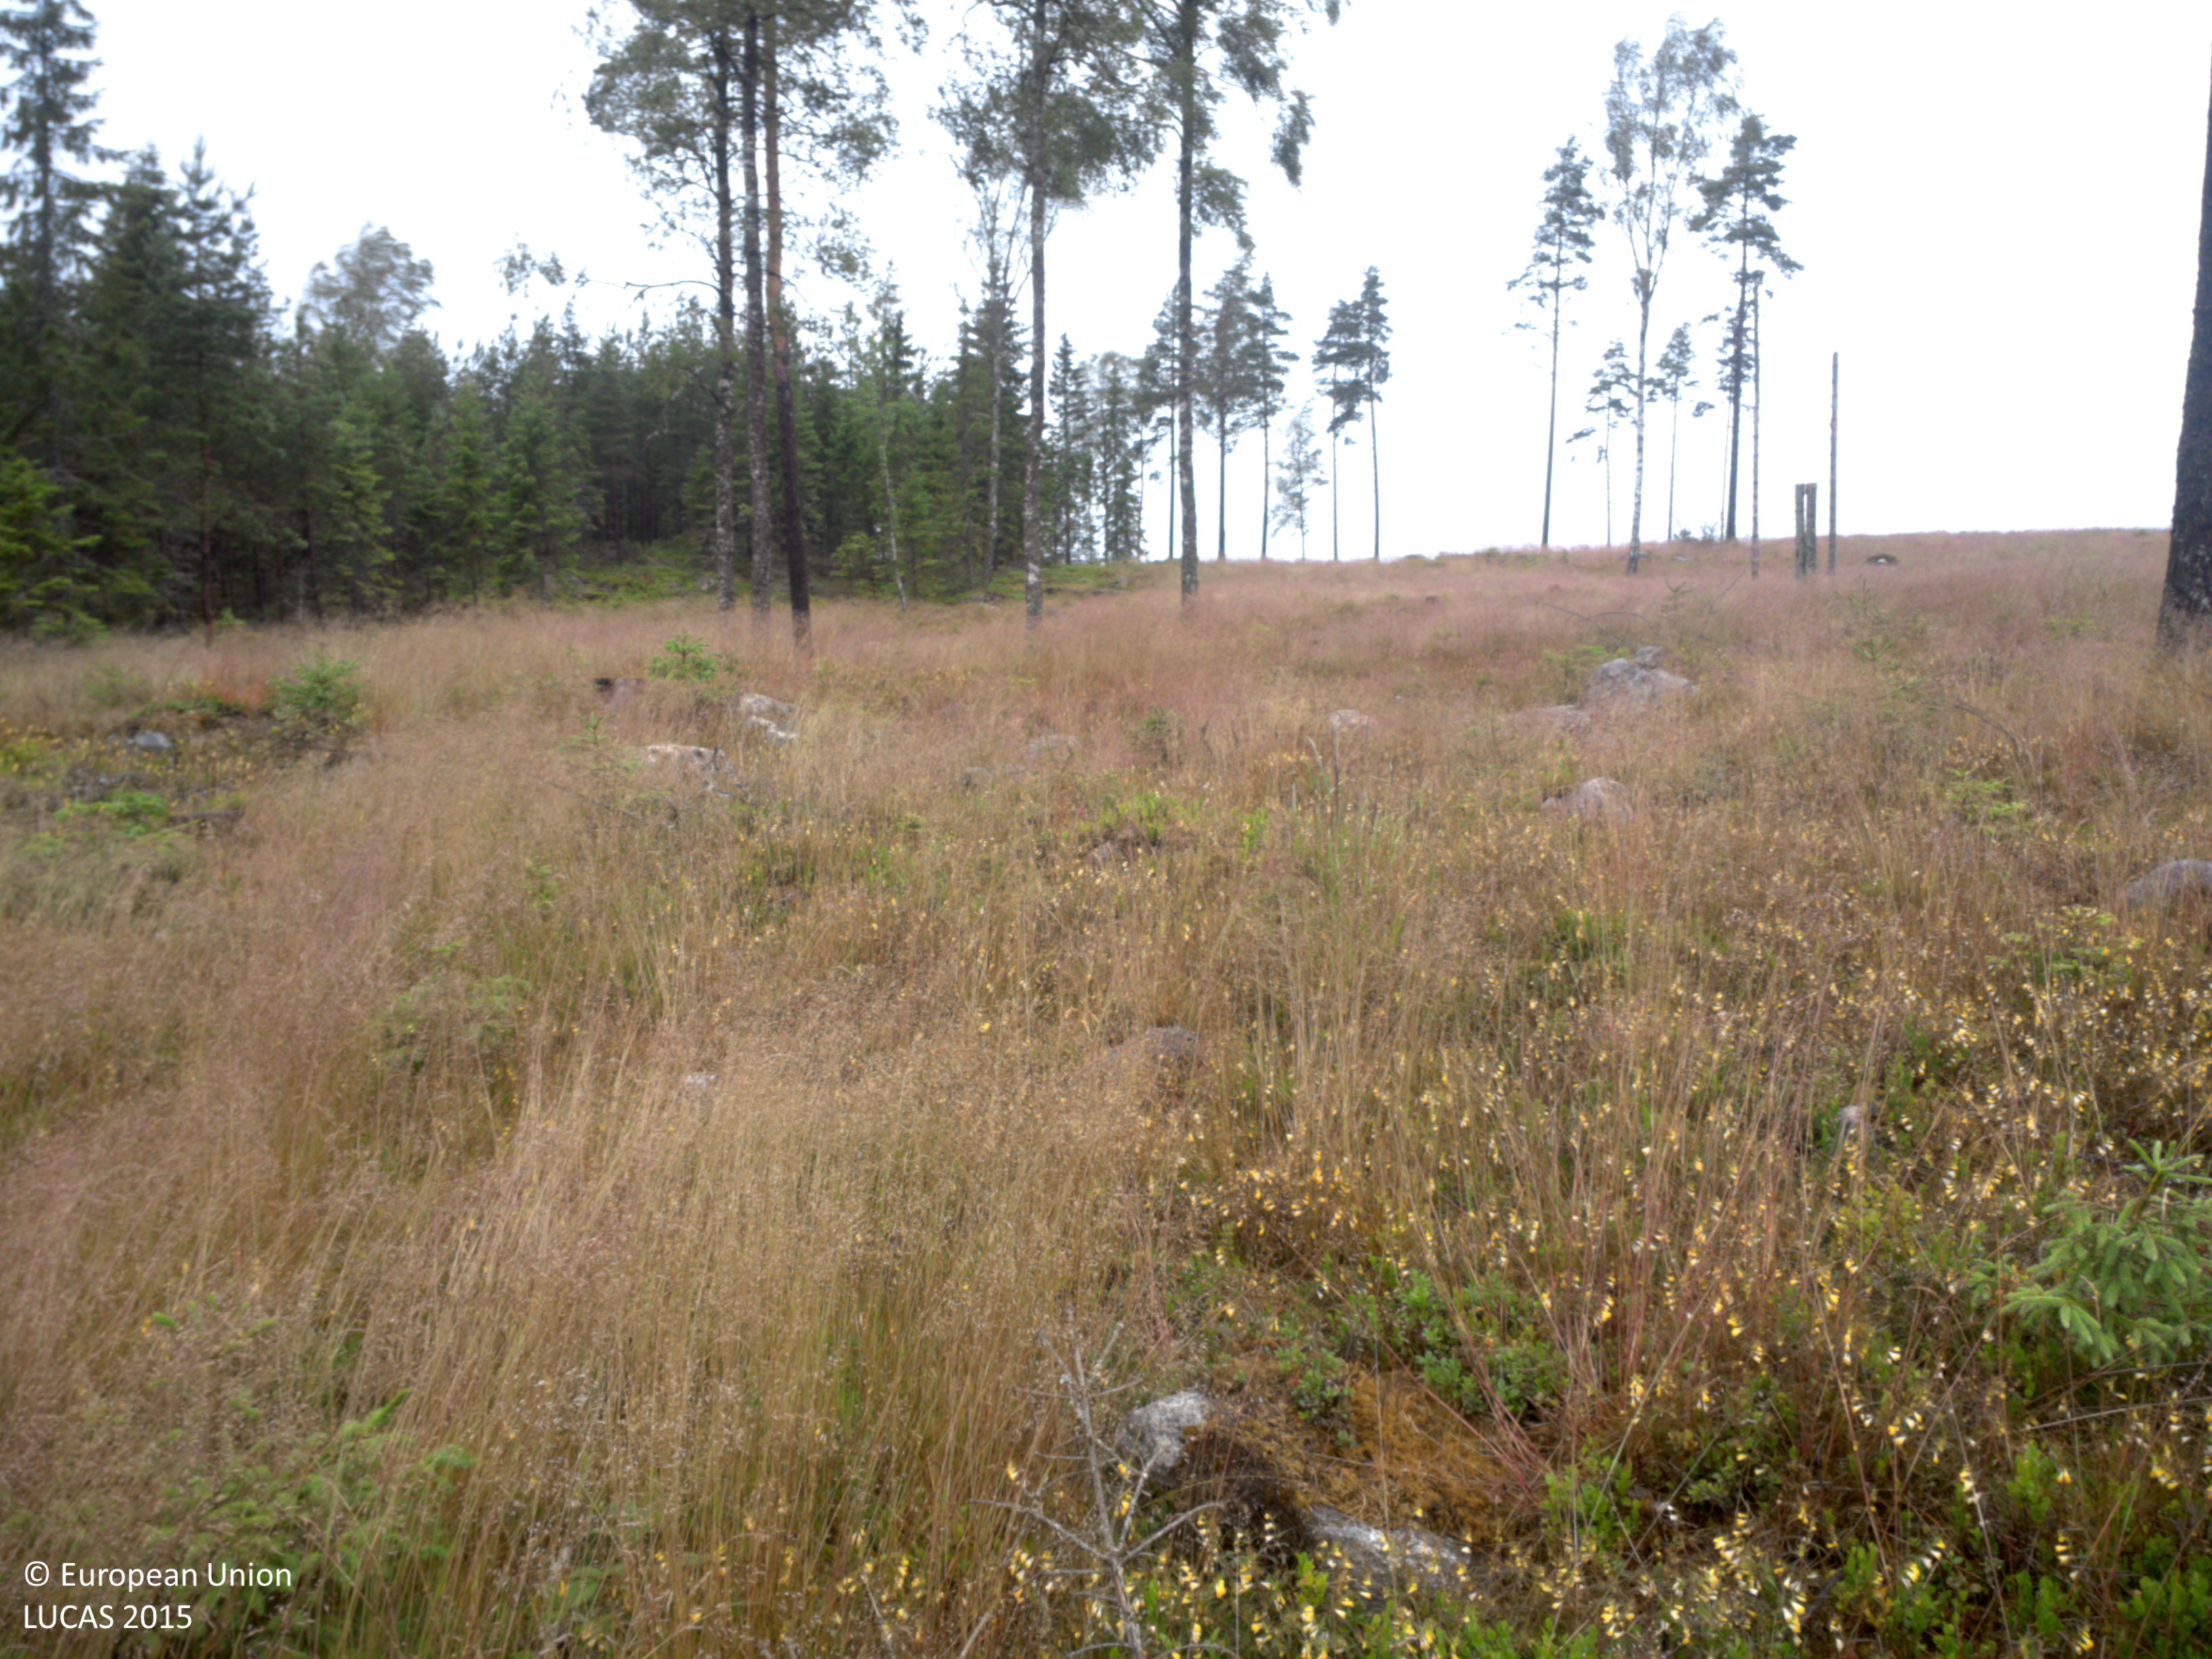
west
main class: Grassland
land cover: Grassland with sparse tree/shrub cover
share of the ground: 25 - 50 %
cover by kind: herbaceous plants 90 %, coniferous forest trees 5 %, shrubs 5 %
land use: Forestry
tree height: > 5 m
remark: Clear cut
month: July
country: SE
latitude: 58.8690
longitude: 12.0936
